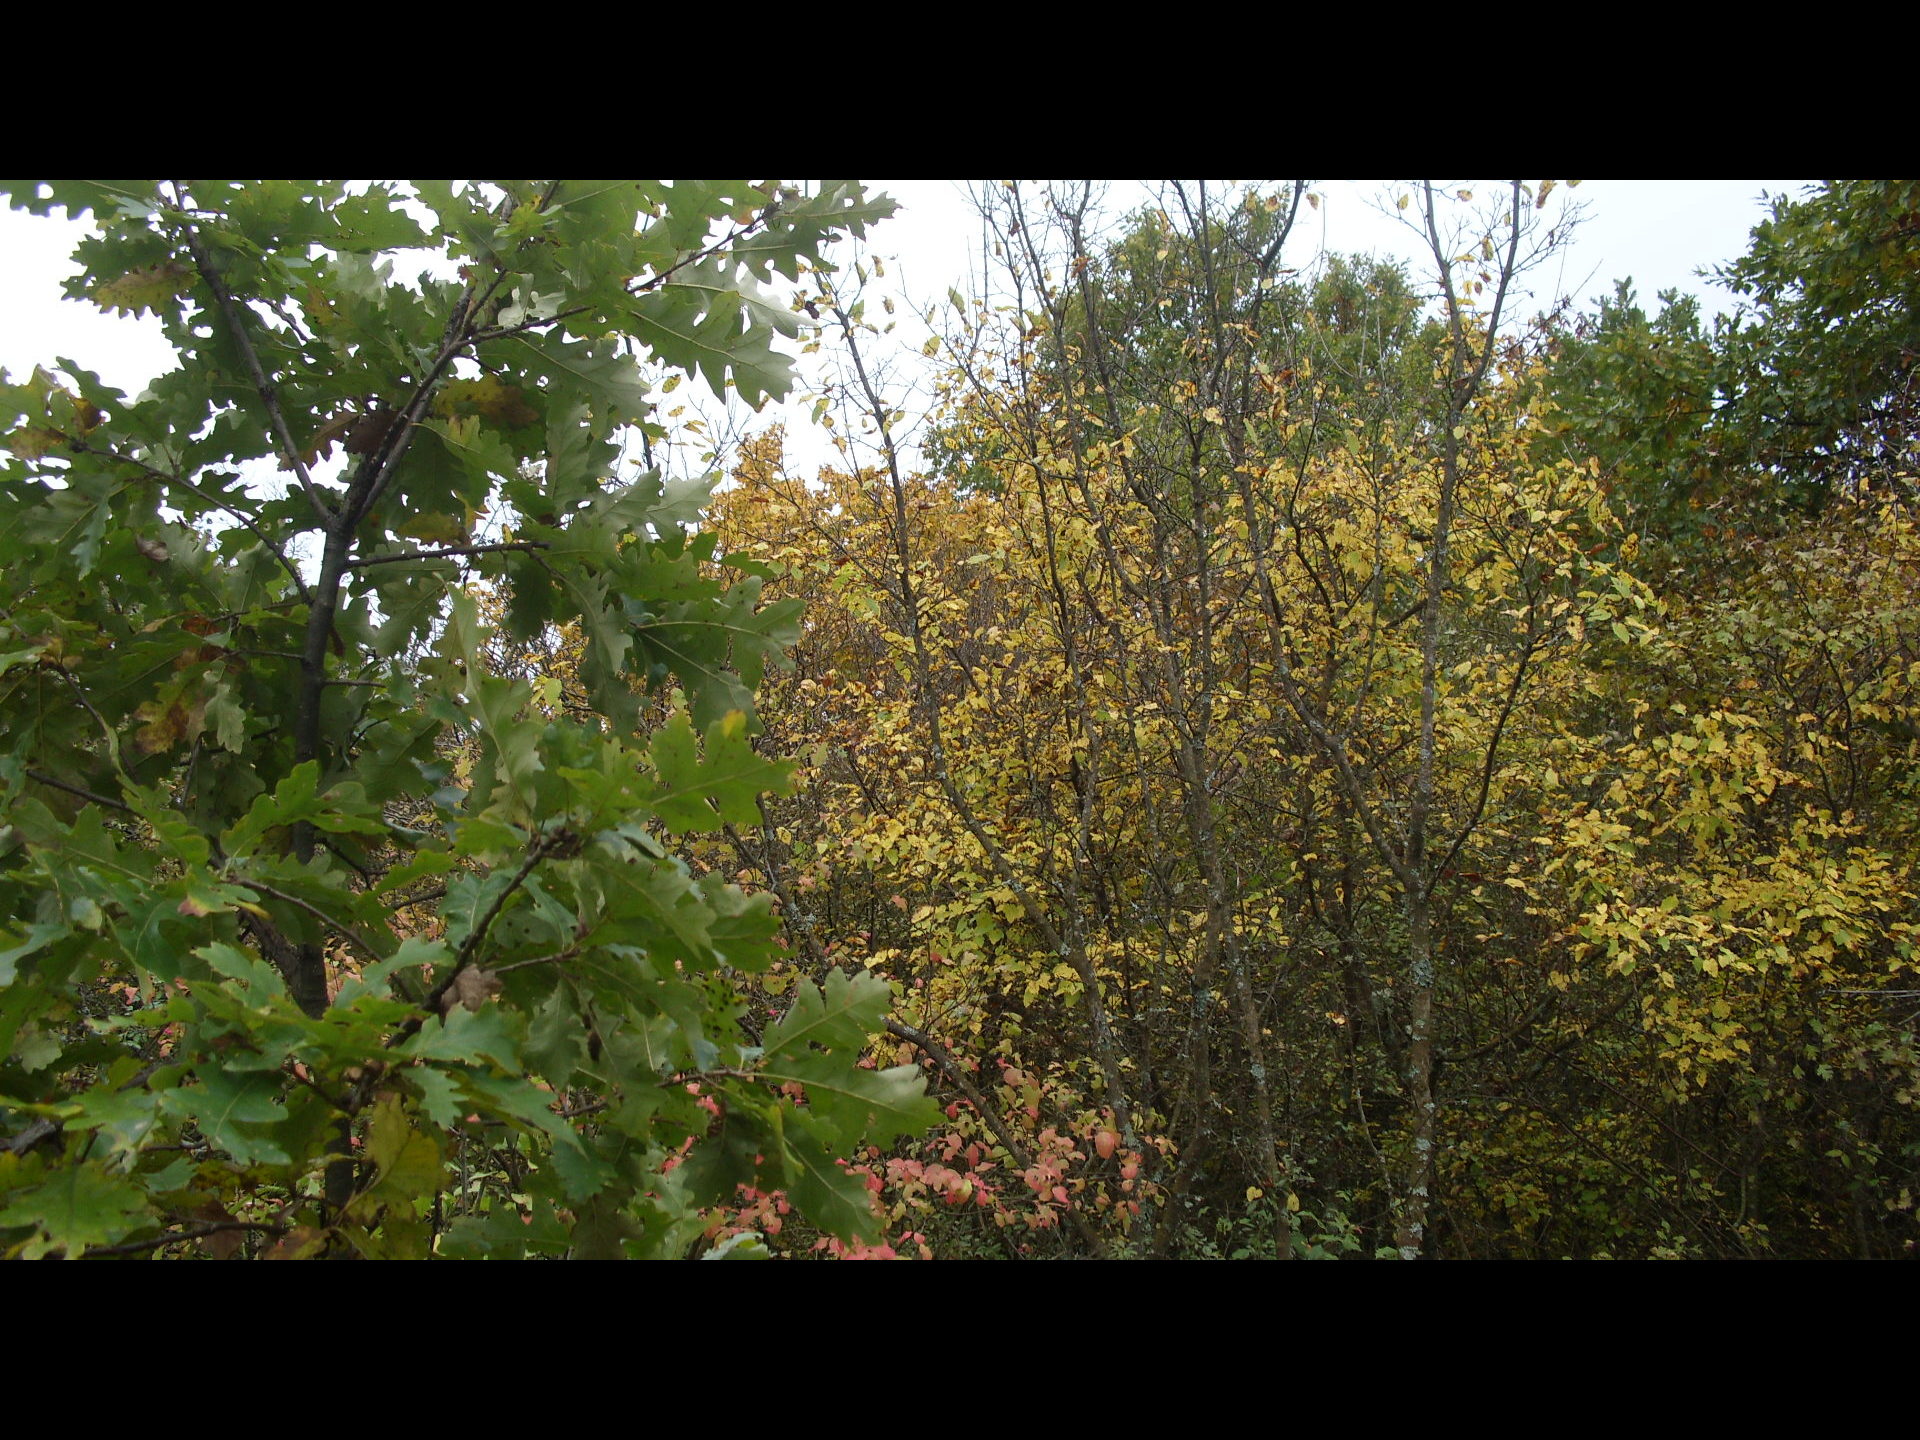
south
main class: Shrubland
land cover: Shrubland with sparse tree cover
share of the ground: > 75 %
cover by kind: shrubs 85 %, herbaceous plants 10 %, broadleaved forest trees 5 %
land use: Semi-natural and natural areas not in use
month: October
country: BG
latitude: 43.6707
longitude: 22.5968
